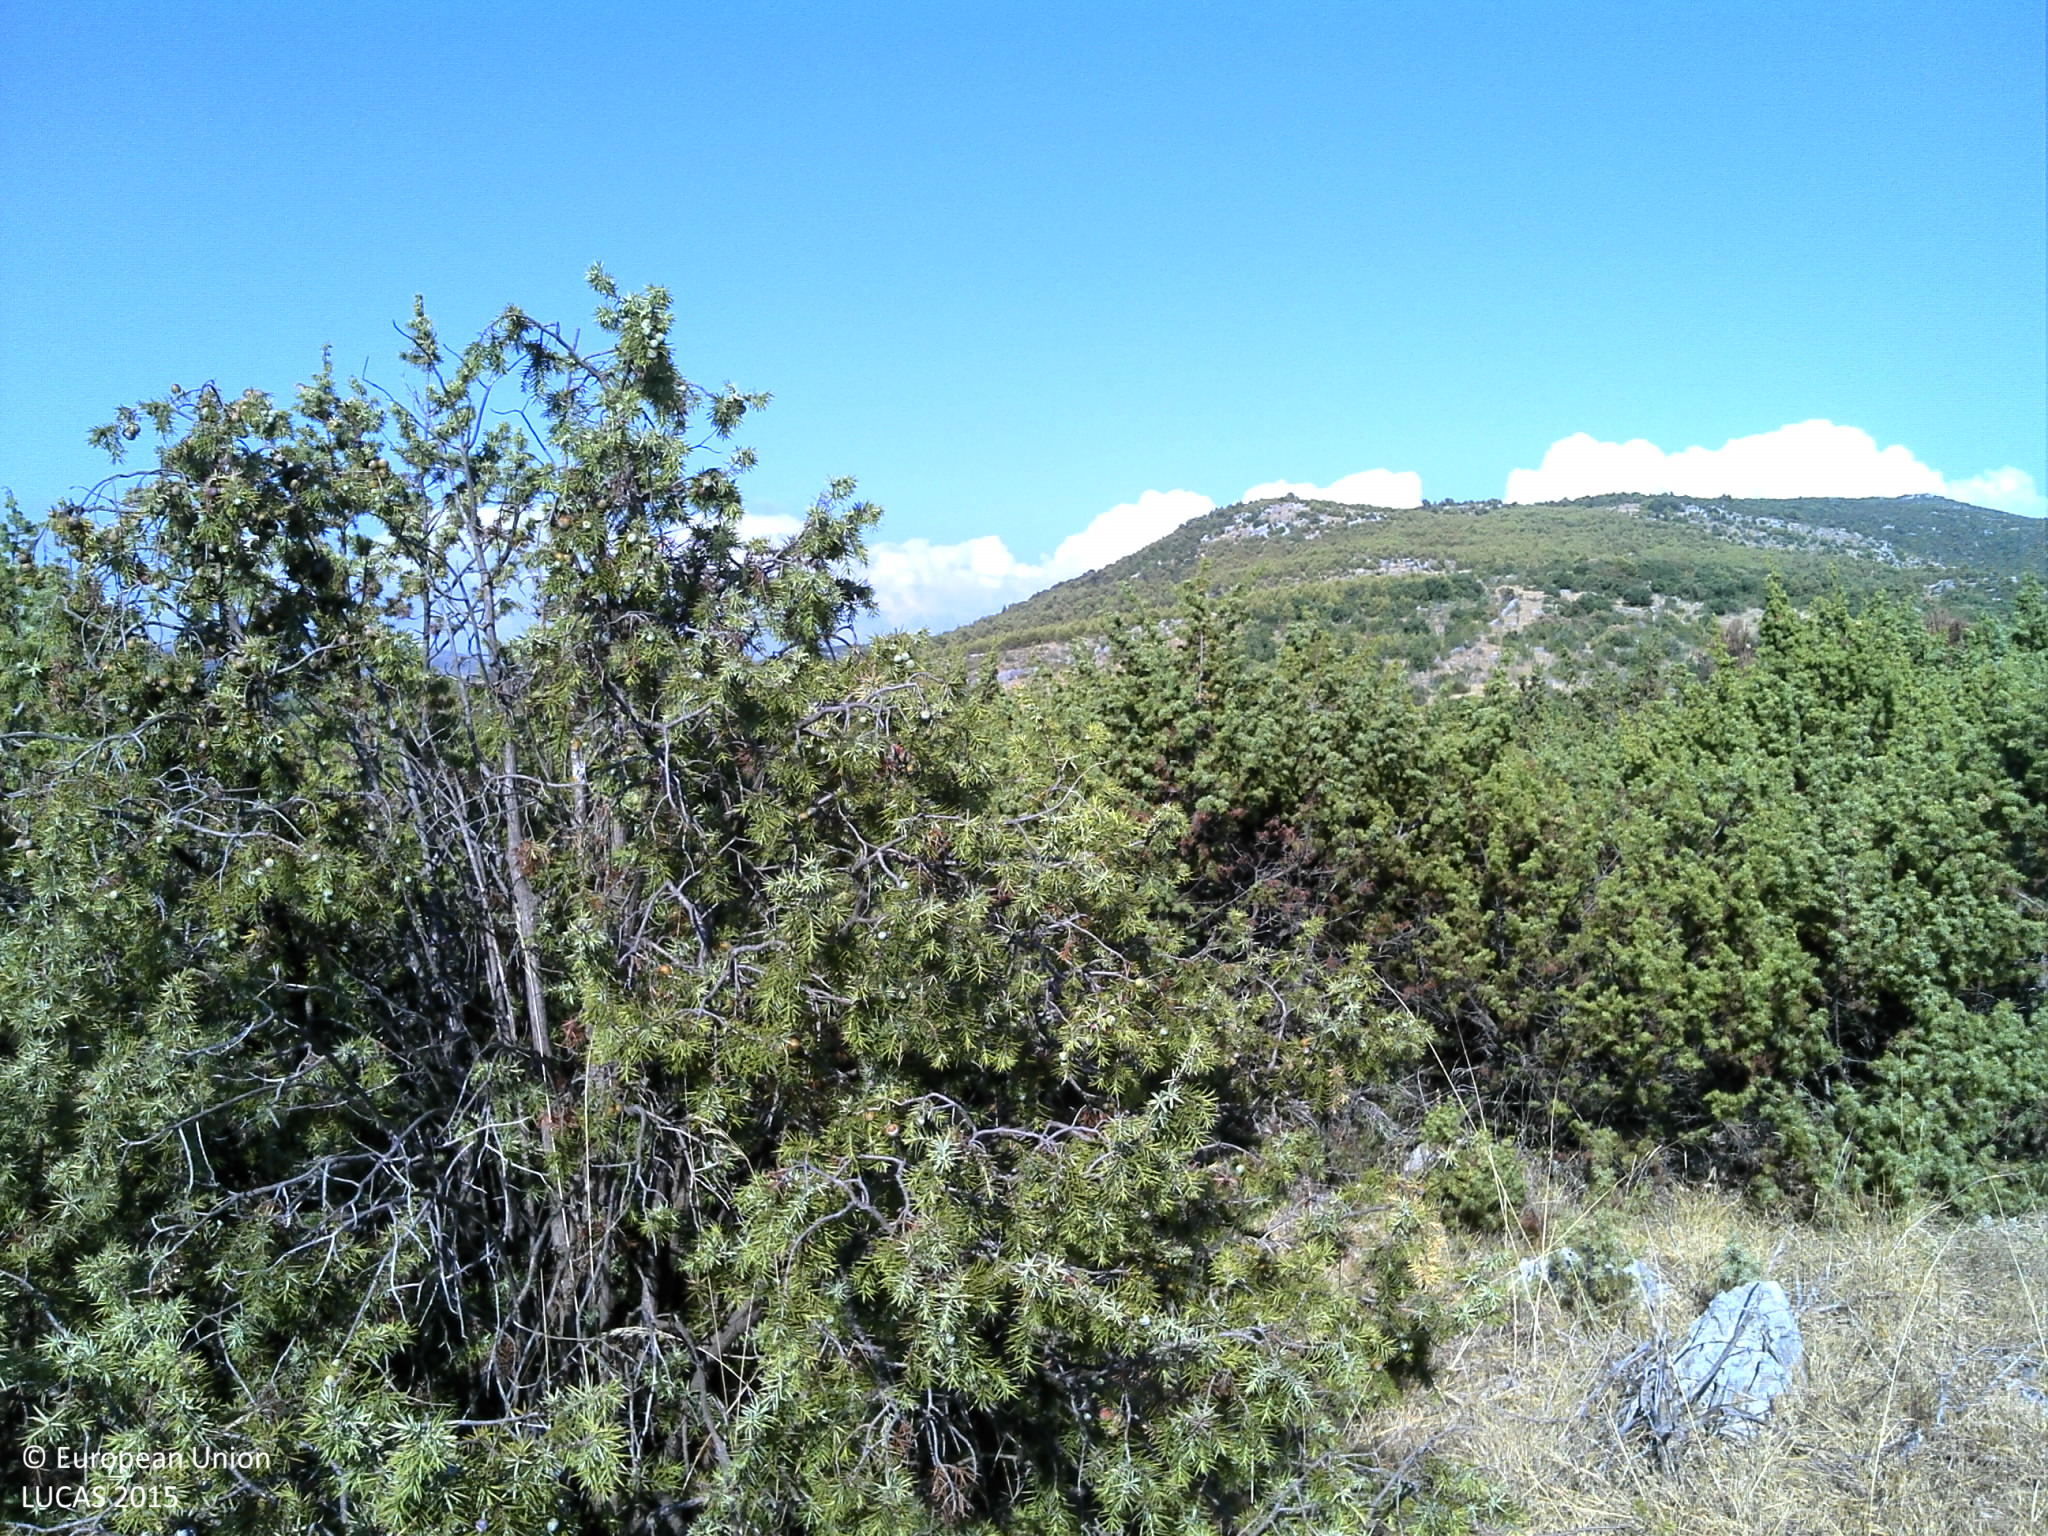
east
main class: Shrubland
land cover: Shrubland without tree cover
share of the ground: 50 - 75 %
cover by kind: shrubs 60 %, herbaceous plants 20 %, consolidated bare surface 10 %, unconsolidated bare surface 10 %
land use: Semi-natural and natural areas not in use
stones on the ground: < 10 %
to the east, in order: Shrubland without tree cover; Dry stone walls; Shrubland without tree cover; Tracks; Shrubland without tree cover; Tracks; Shrubland without tree cover
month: July
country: HR
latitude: 43.6673
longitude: 16.0554
